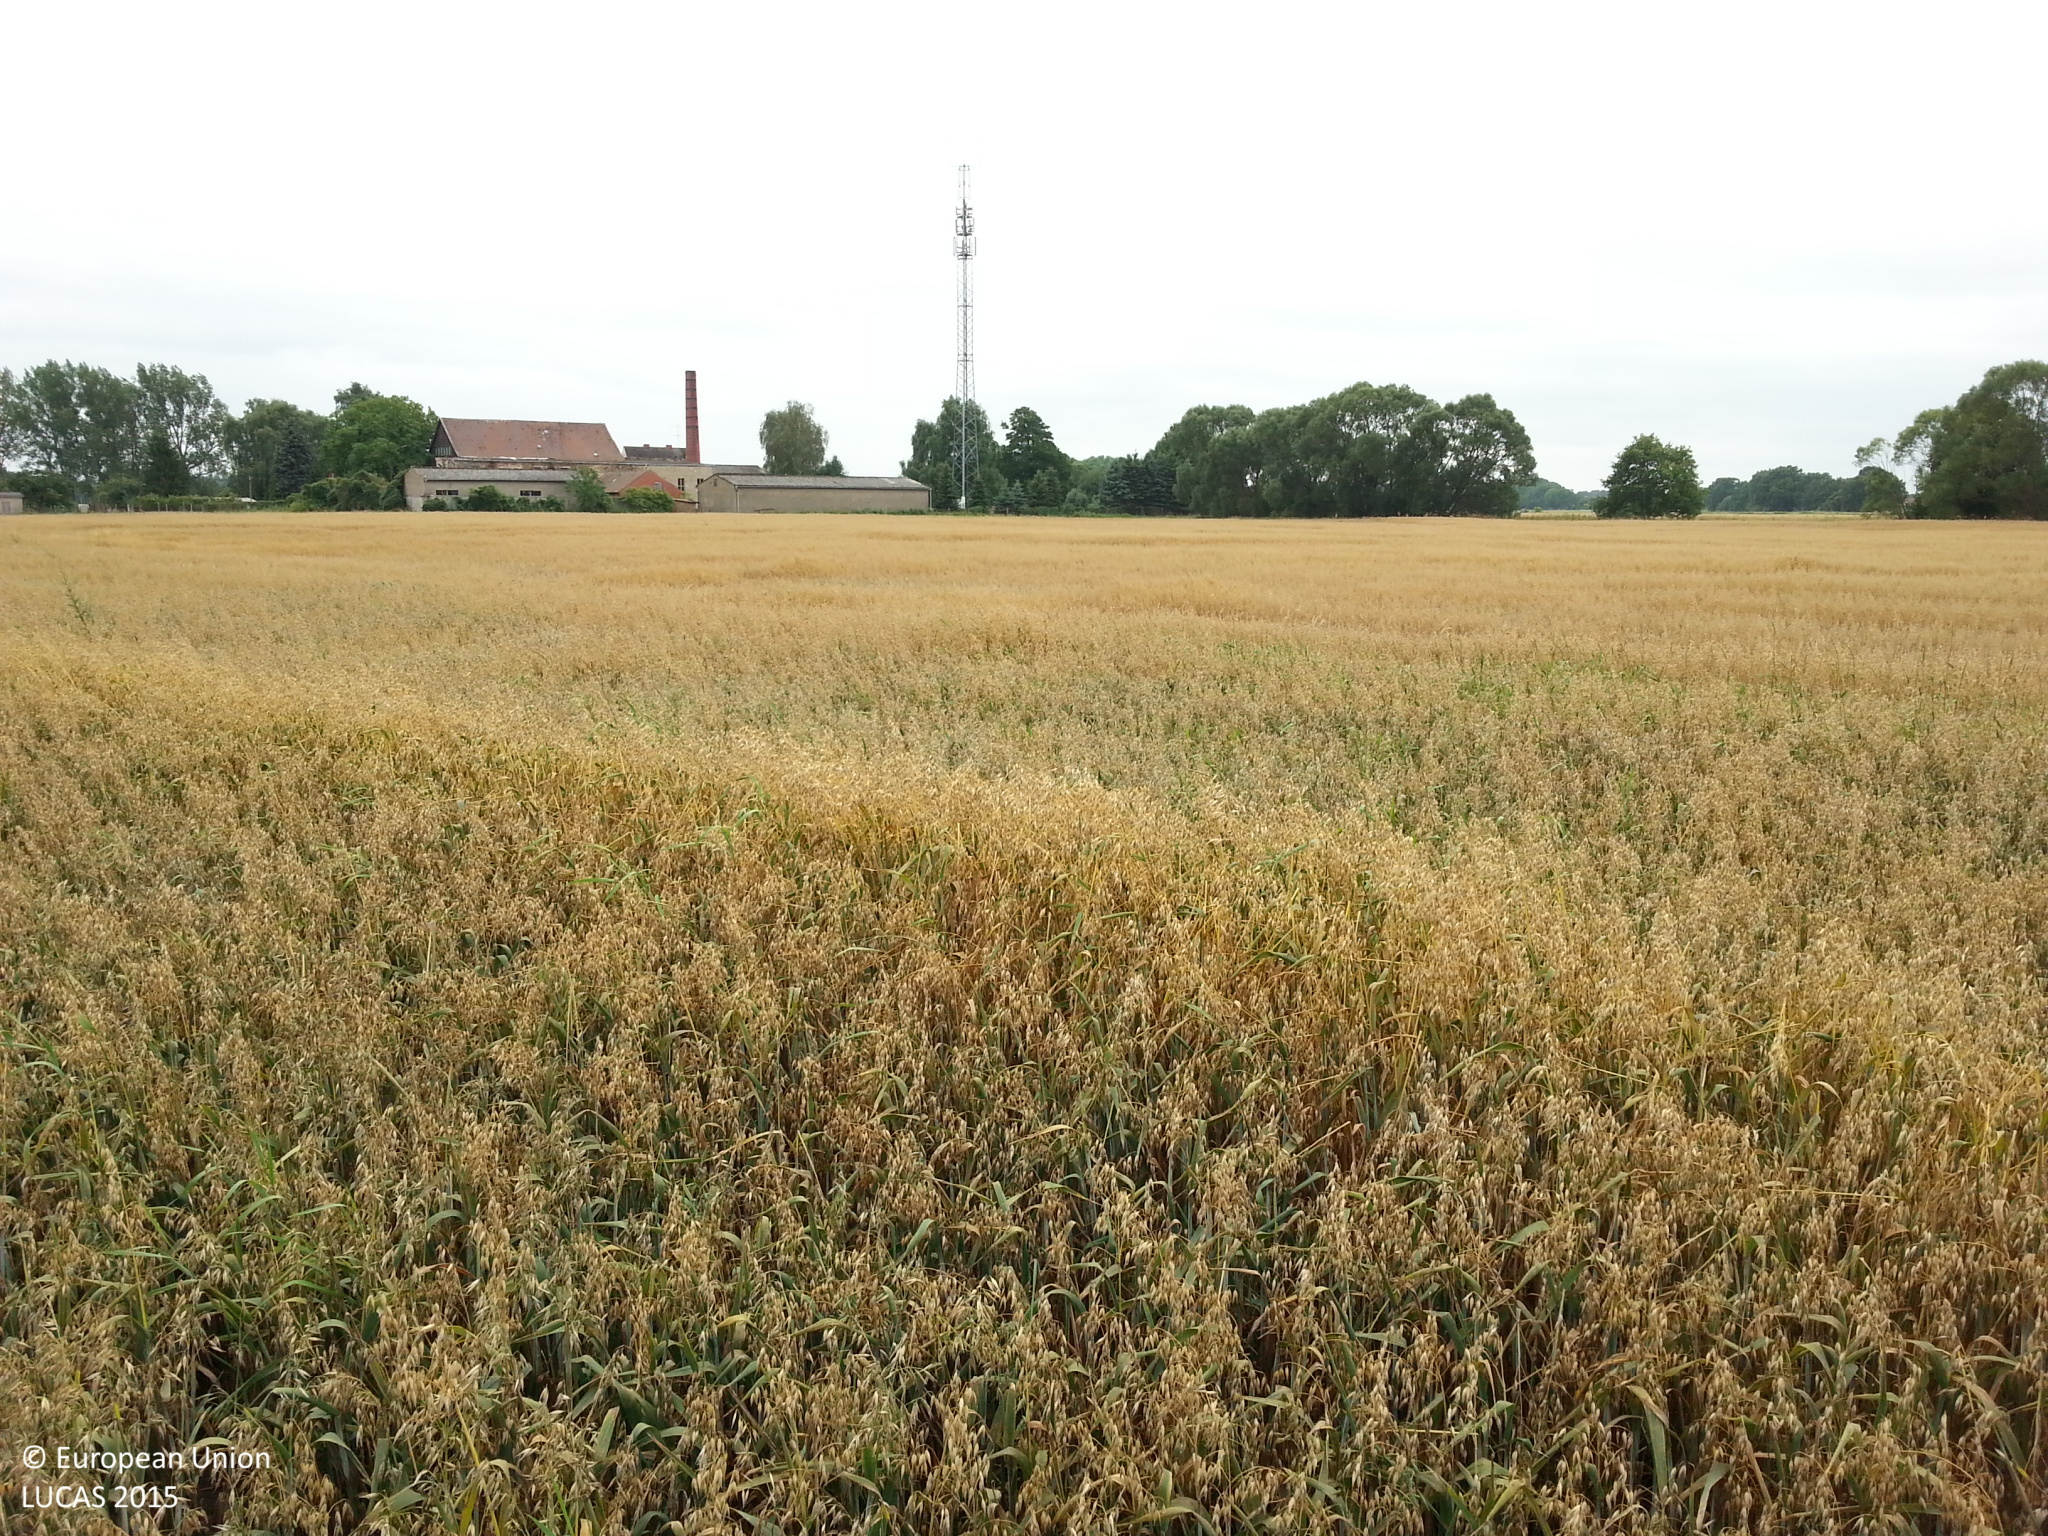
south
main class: Cropland
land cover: Barley
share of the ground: > 75 %
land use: Agriculture (excluding fallow land and kitchen gardens)
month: July
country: DE
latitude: 53.0736
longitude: 12.3428
